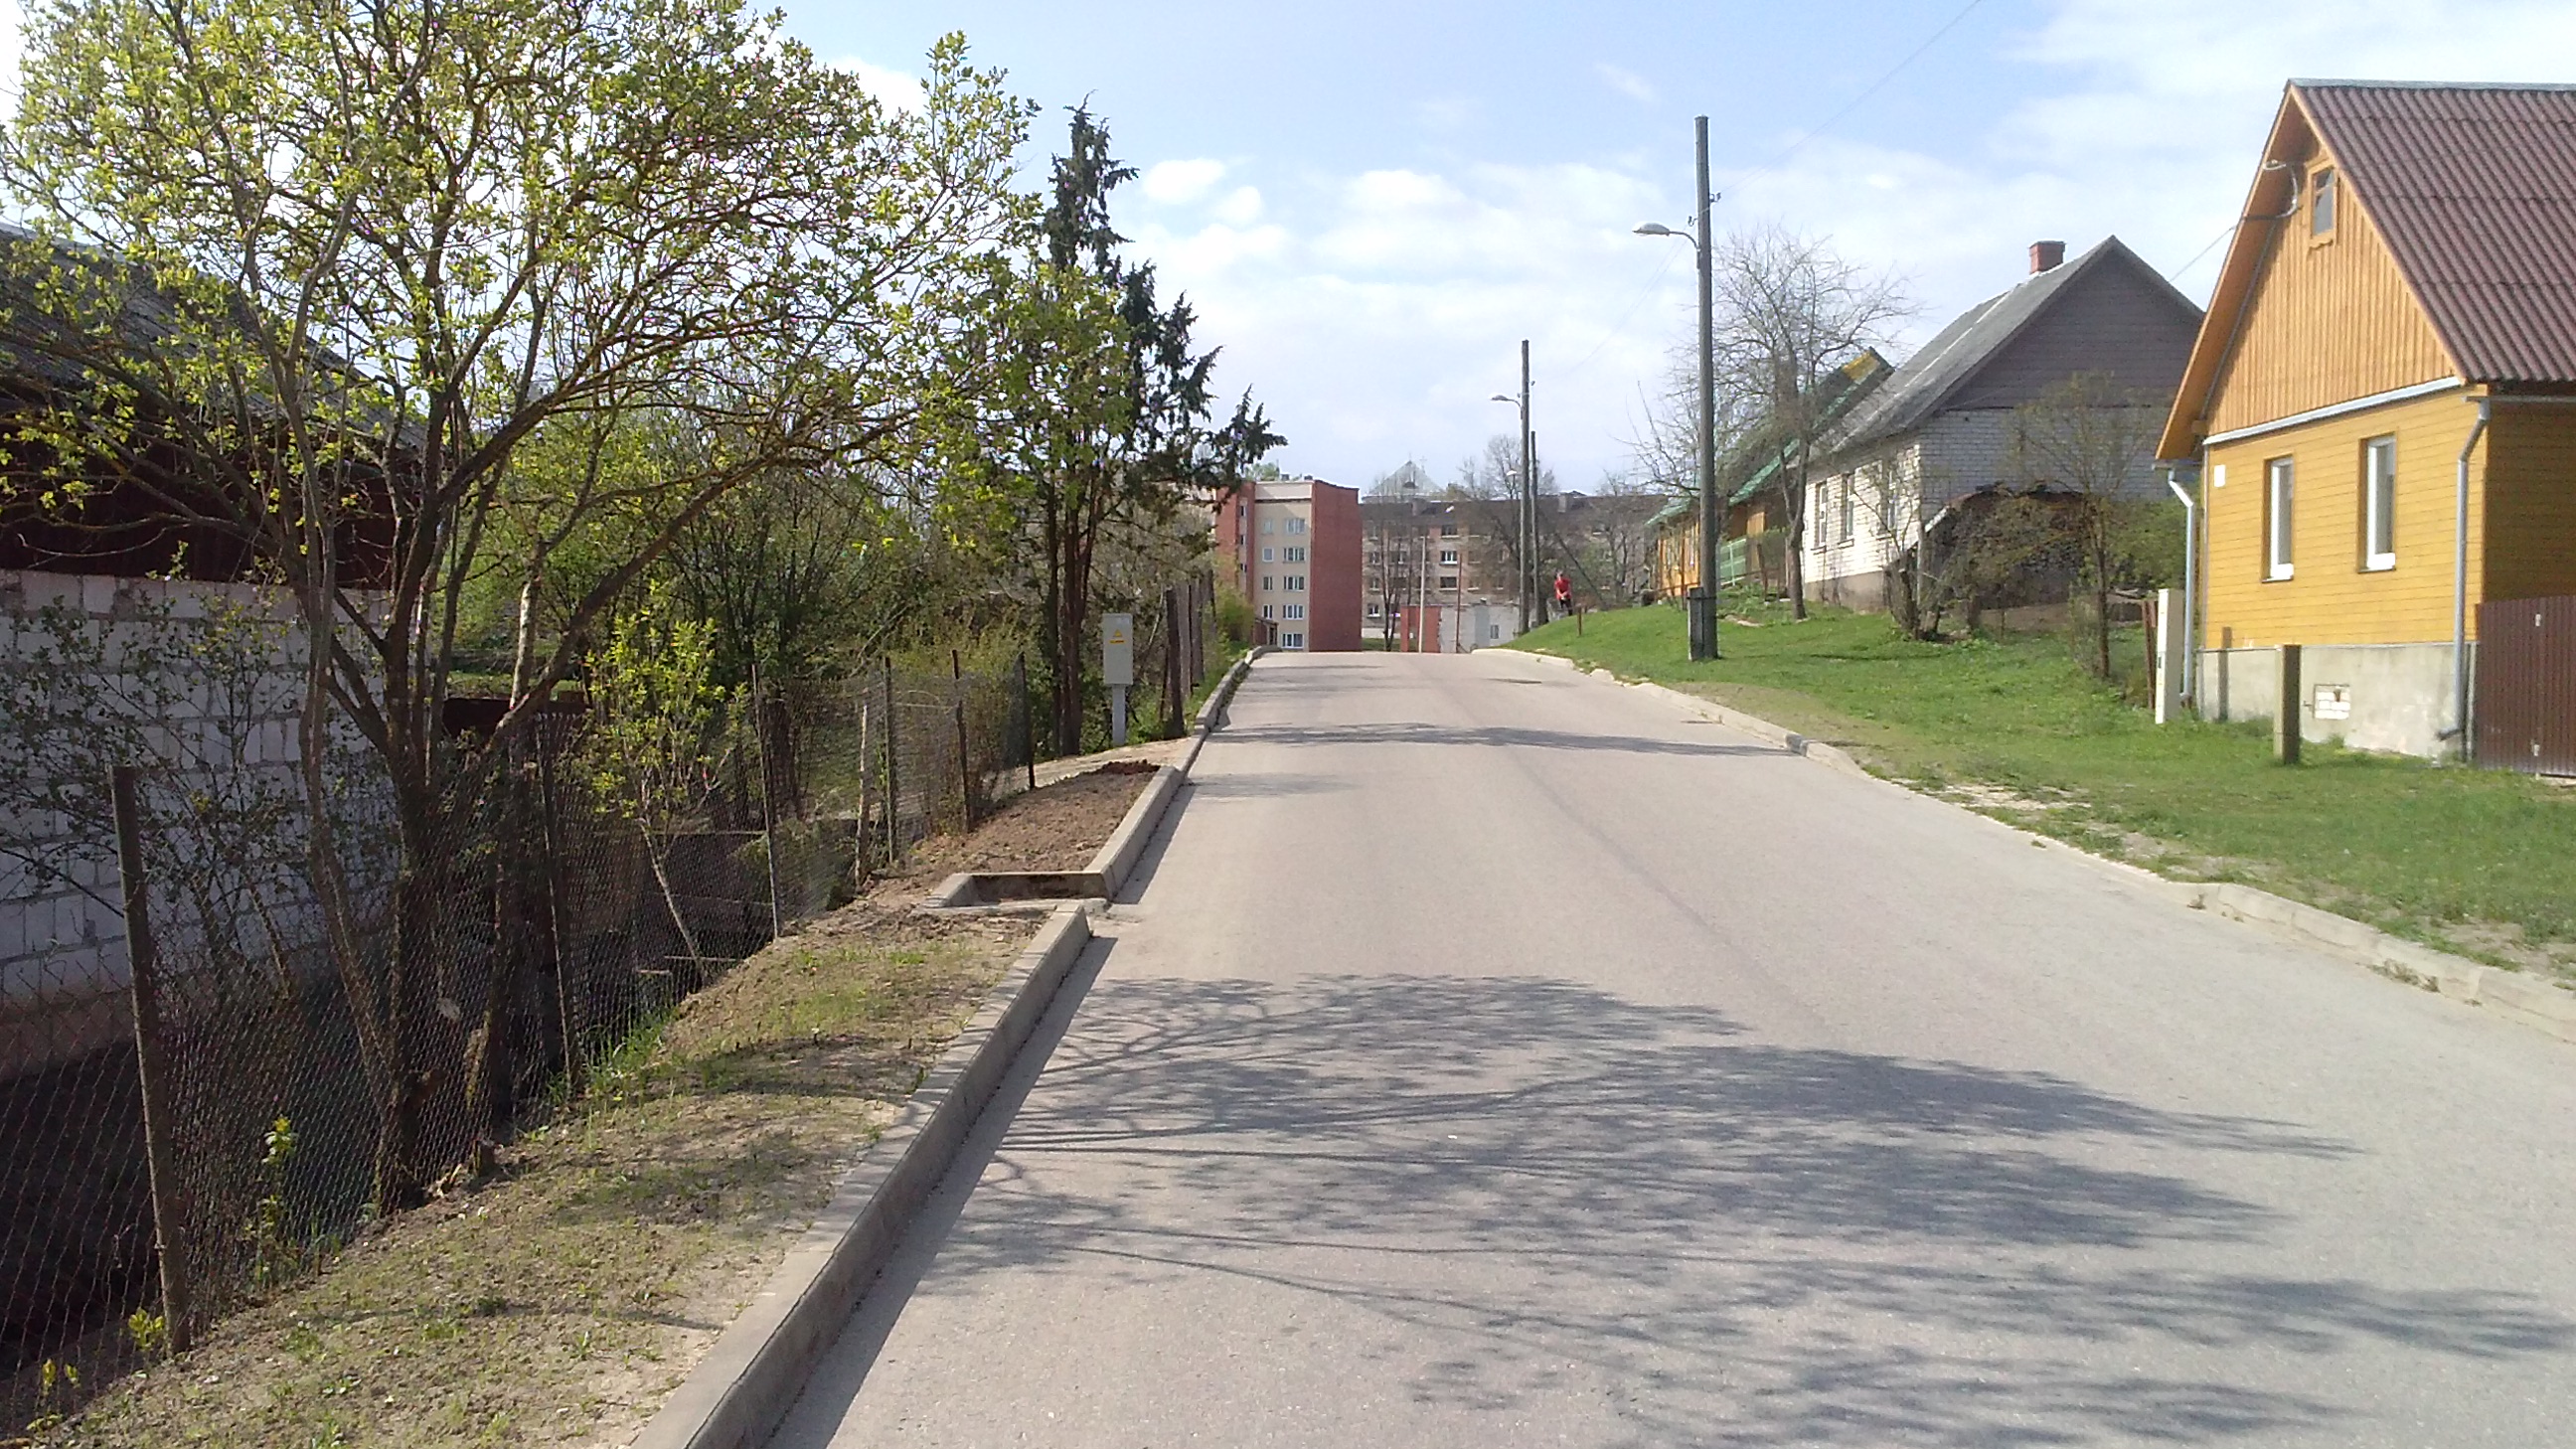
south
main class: Cropland
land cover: Apple fruit
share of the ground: > 75 %
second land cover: Grassland without tree/shrub cover
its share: > 75 %
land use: Kitchen garden
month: May
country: LV
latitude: 55.9015
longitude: 27.1730
